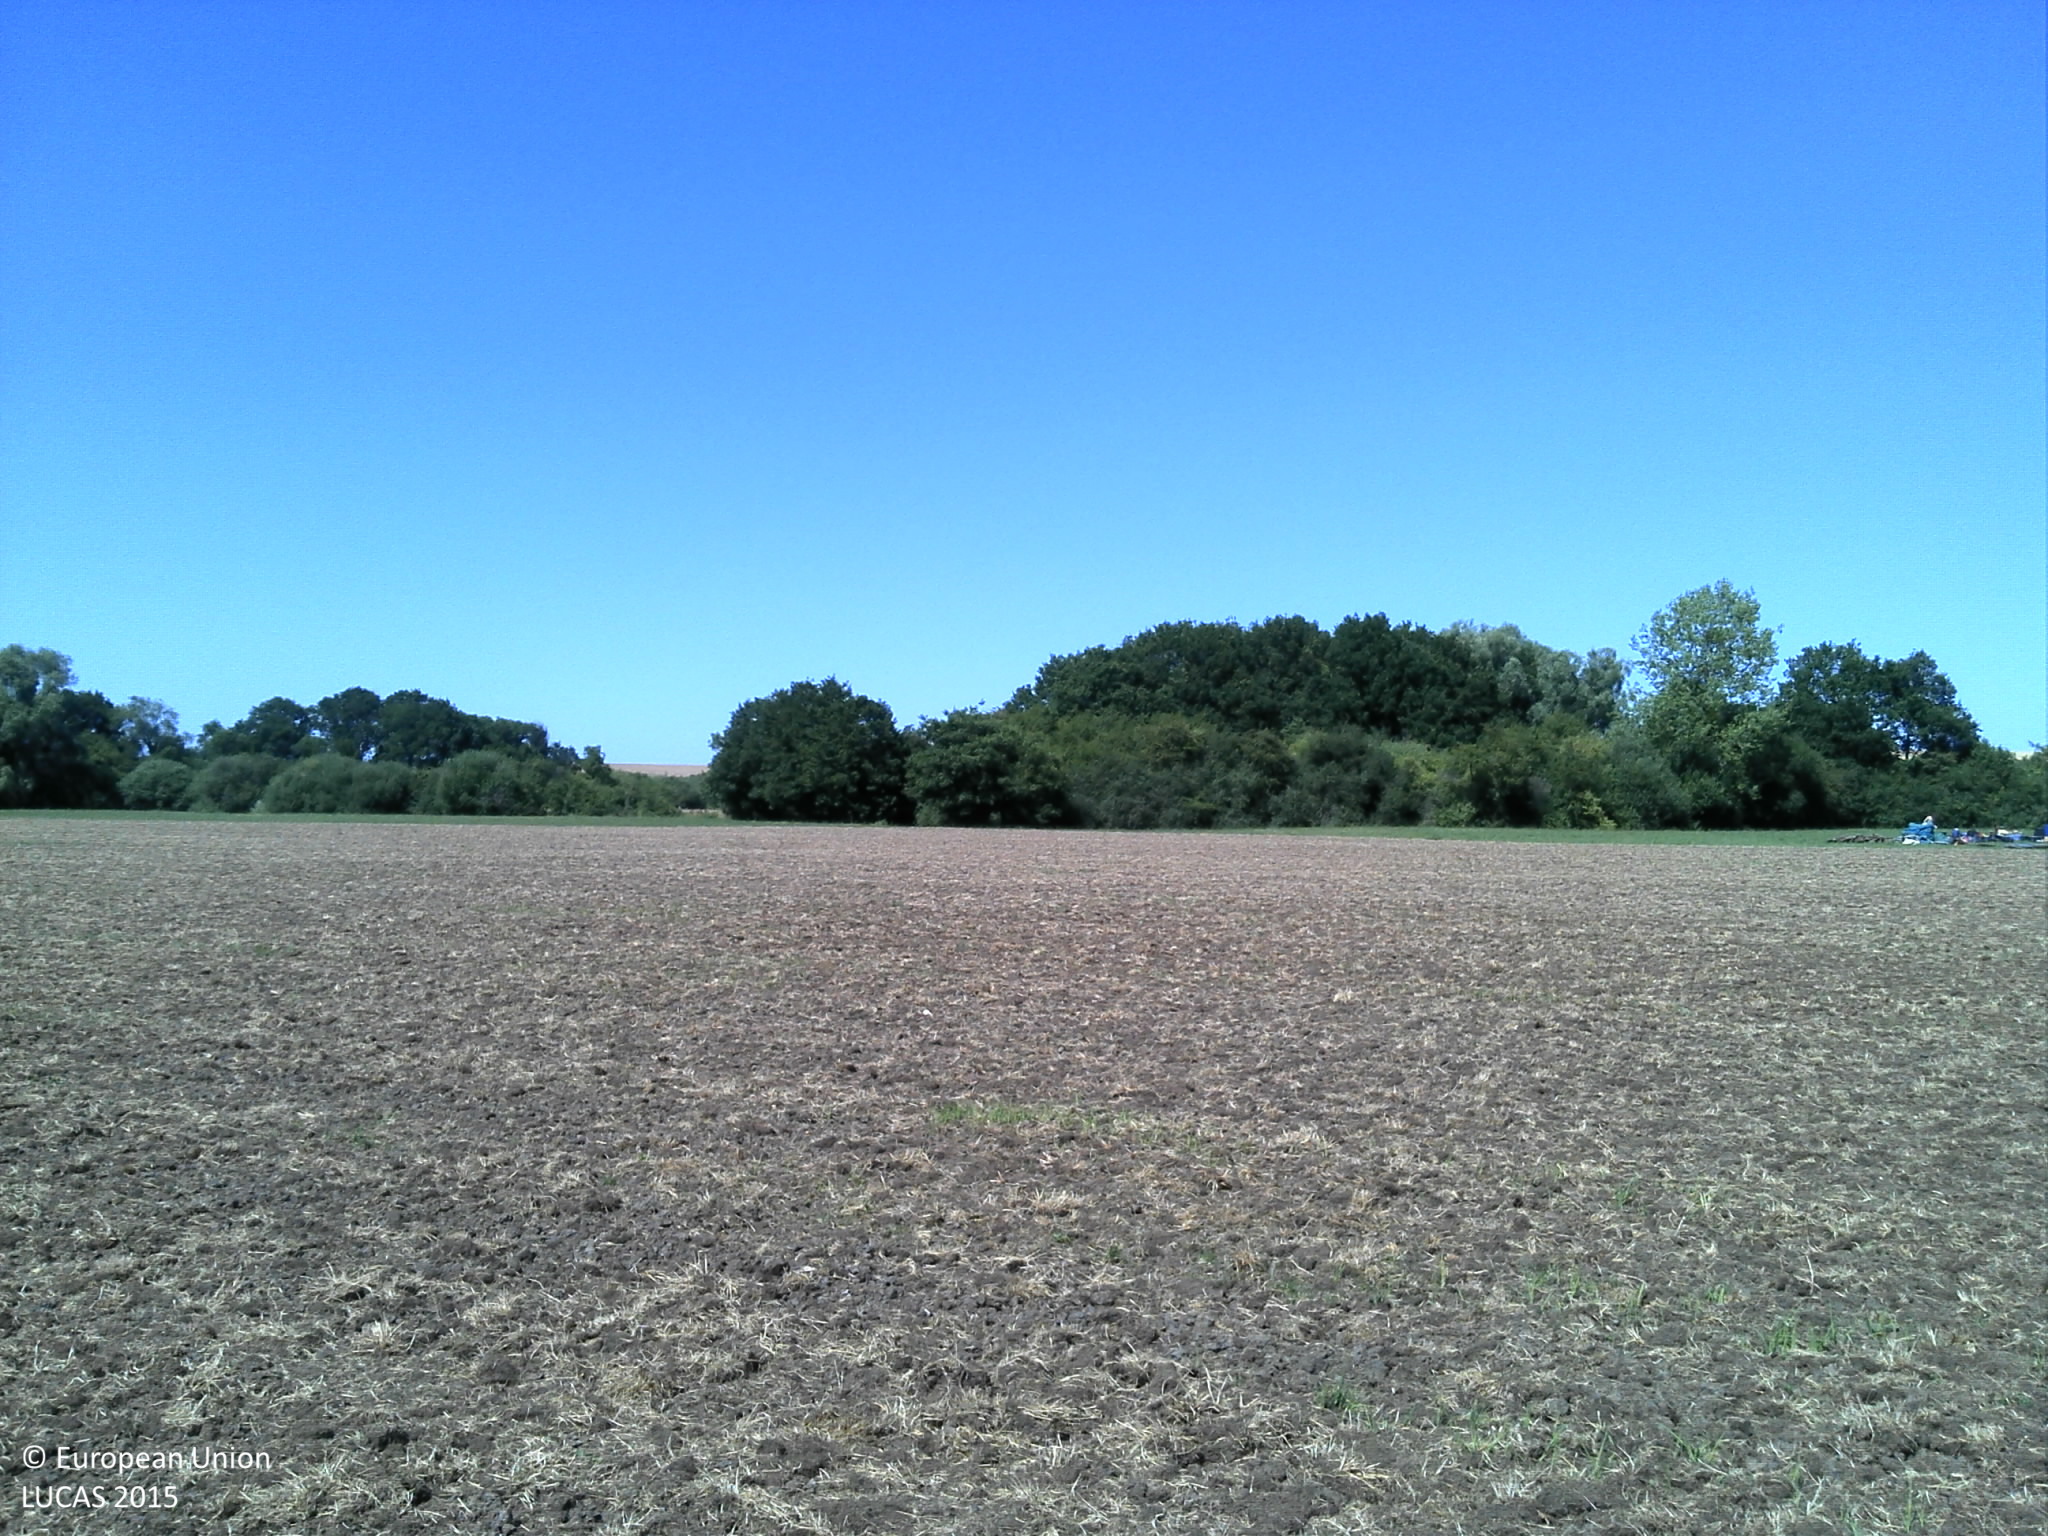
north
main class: Grassland
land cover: Grassland without tree/shrub cover
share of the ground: > 75 %
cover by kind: herbaceous plants 100 %
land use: Agriculture (excluding fallow land and kitchen gardens)
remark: Tilled/Sowed
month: July
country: FR
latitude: 49.4899
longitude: 4.8202
